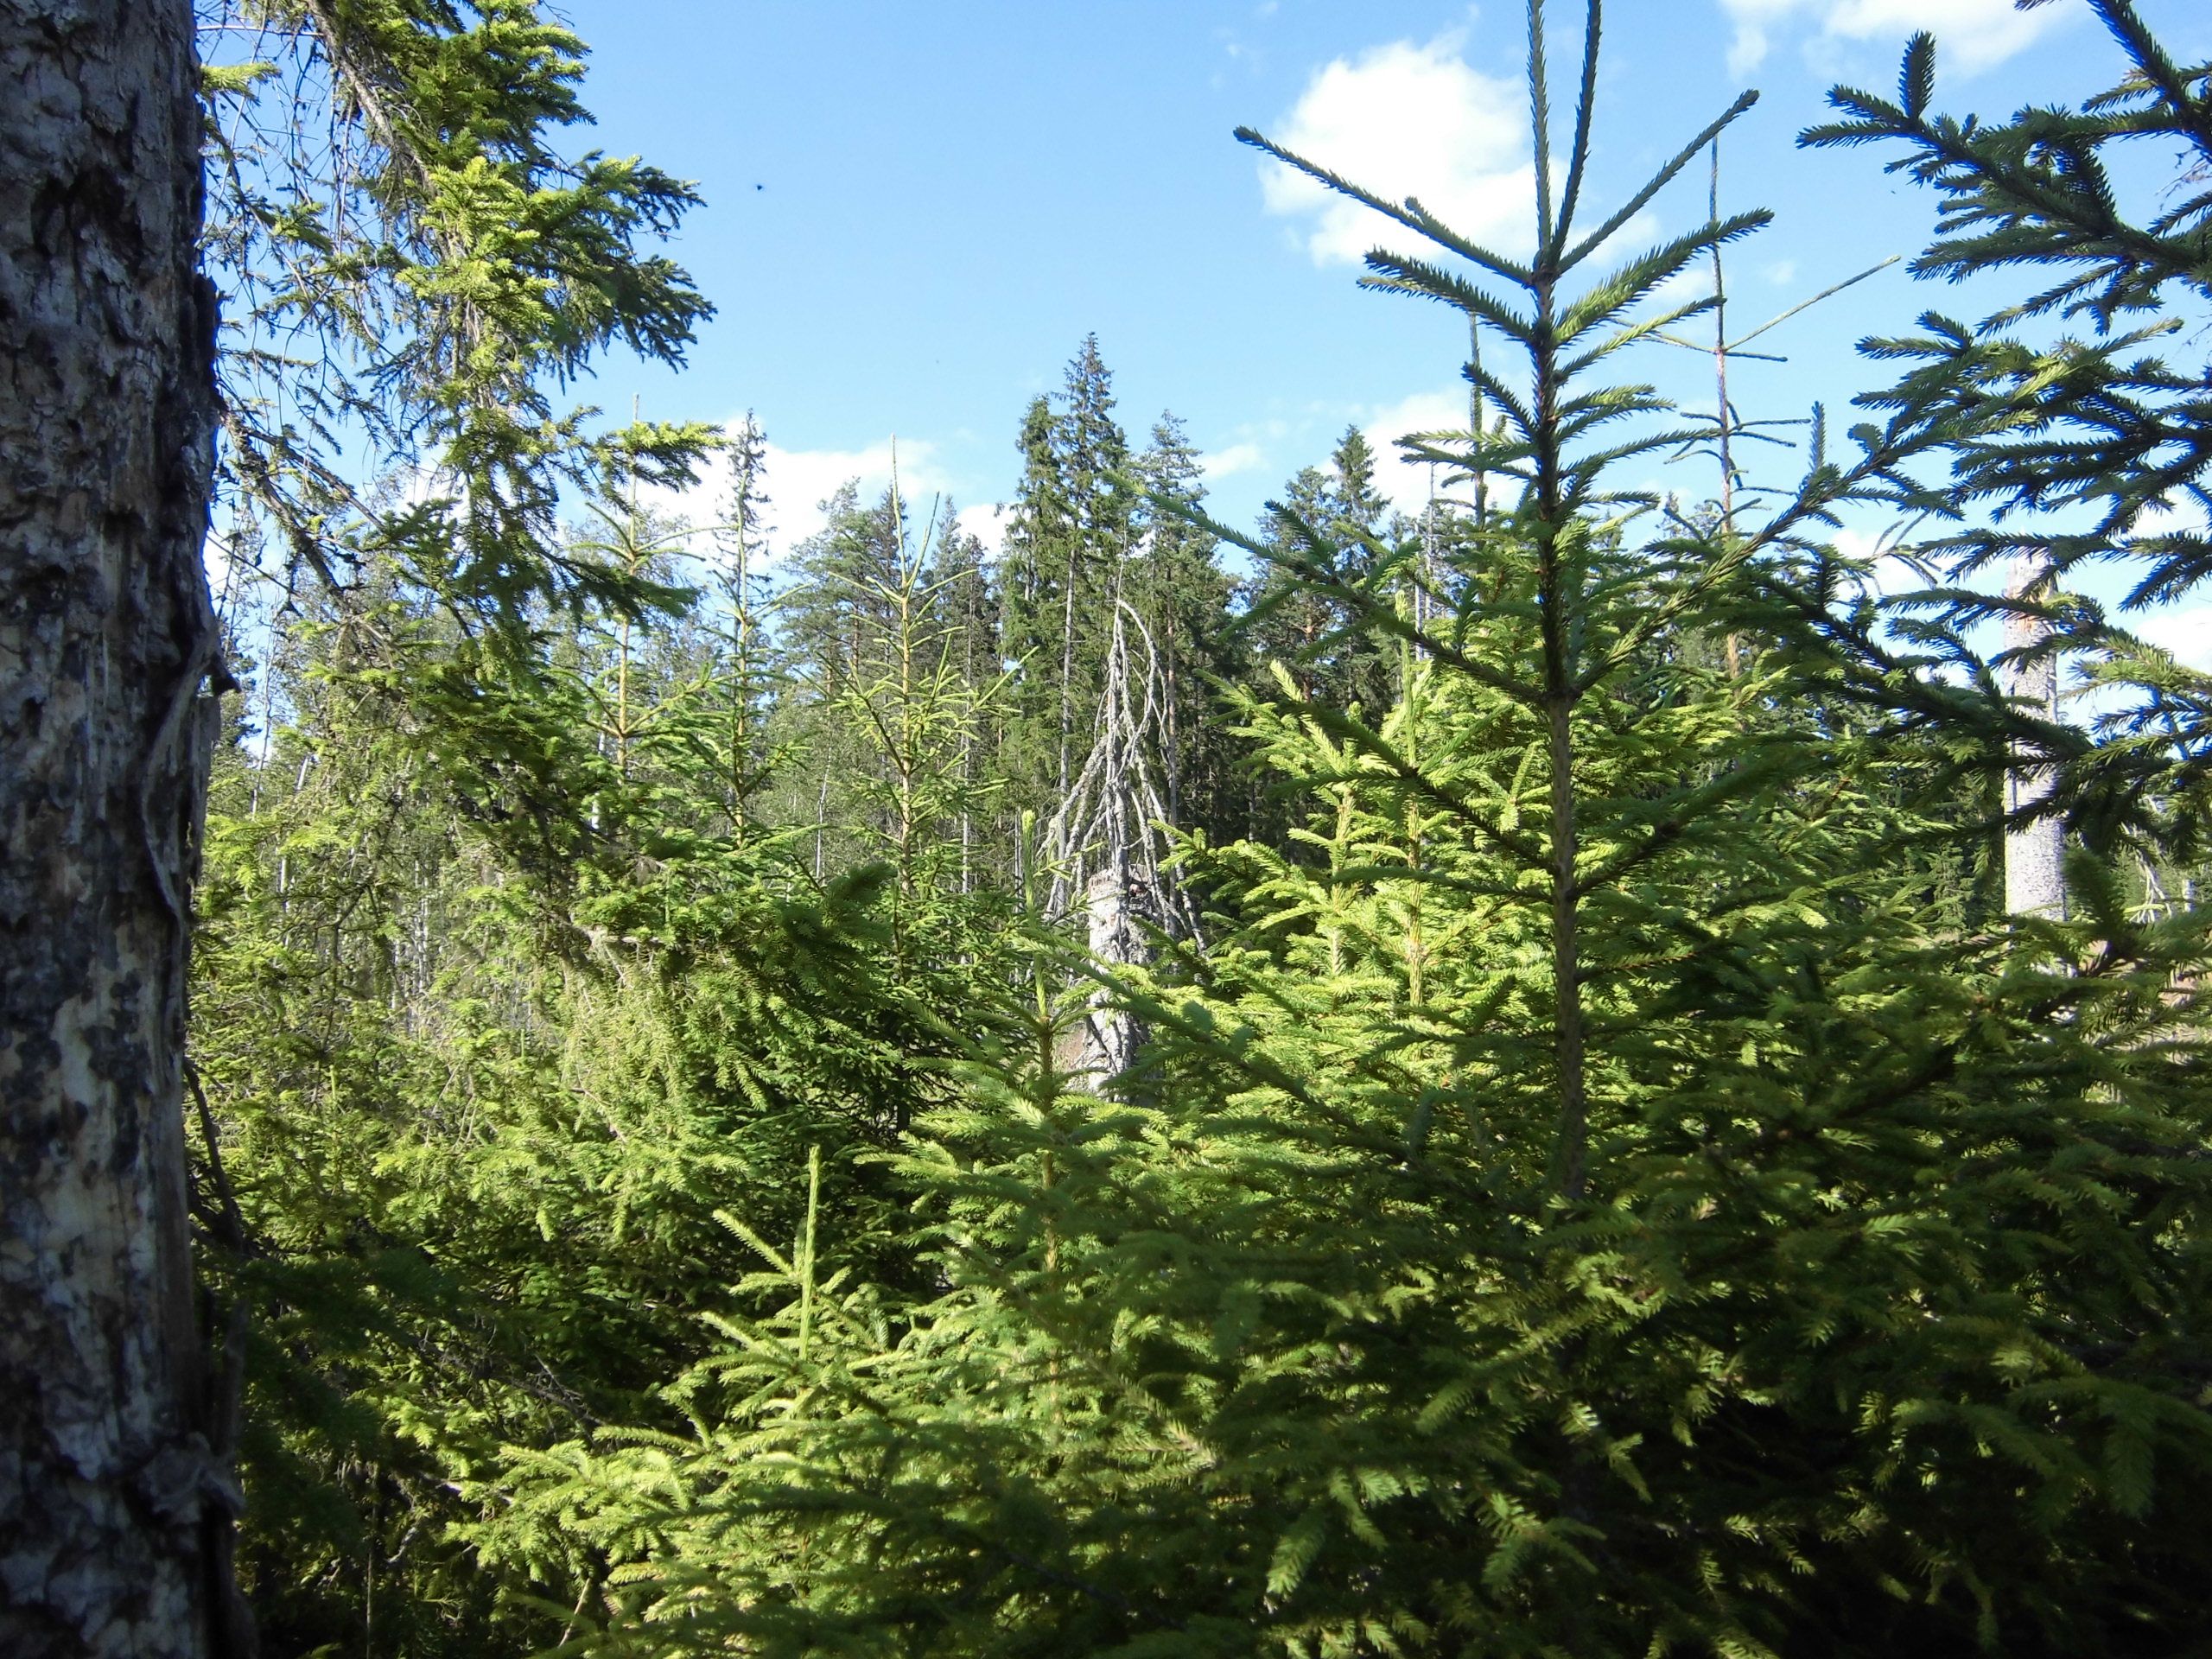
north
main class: Woodland
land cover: Spruce dominated coniferous woodland
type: boreal forest
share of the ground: > 75 %
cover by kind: coniferous forest trees 70 %, broadleaved forest trees 10 %, shrubs 10 %, herbaceous plants 10 %
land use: Forestry
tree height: > 5 m
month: July
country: SE
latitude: 57.2602
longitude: 15.4848
